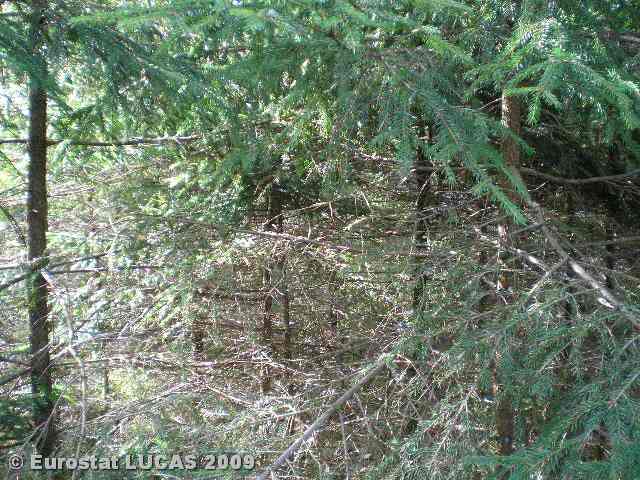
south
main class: Woodland
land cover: Coniferous woodland
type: hemiboreal forest and nemoral coniferous forest and mixed broadleaved-coniferous forest
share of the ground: > 75 %
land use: Forestry
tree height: > 5 m
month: August
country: LT
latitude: 54.8035
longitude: 25.4489
